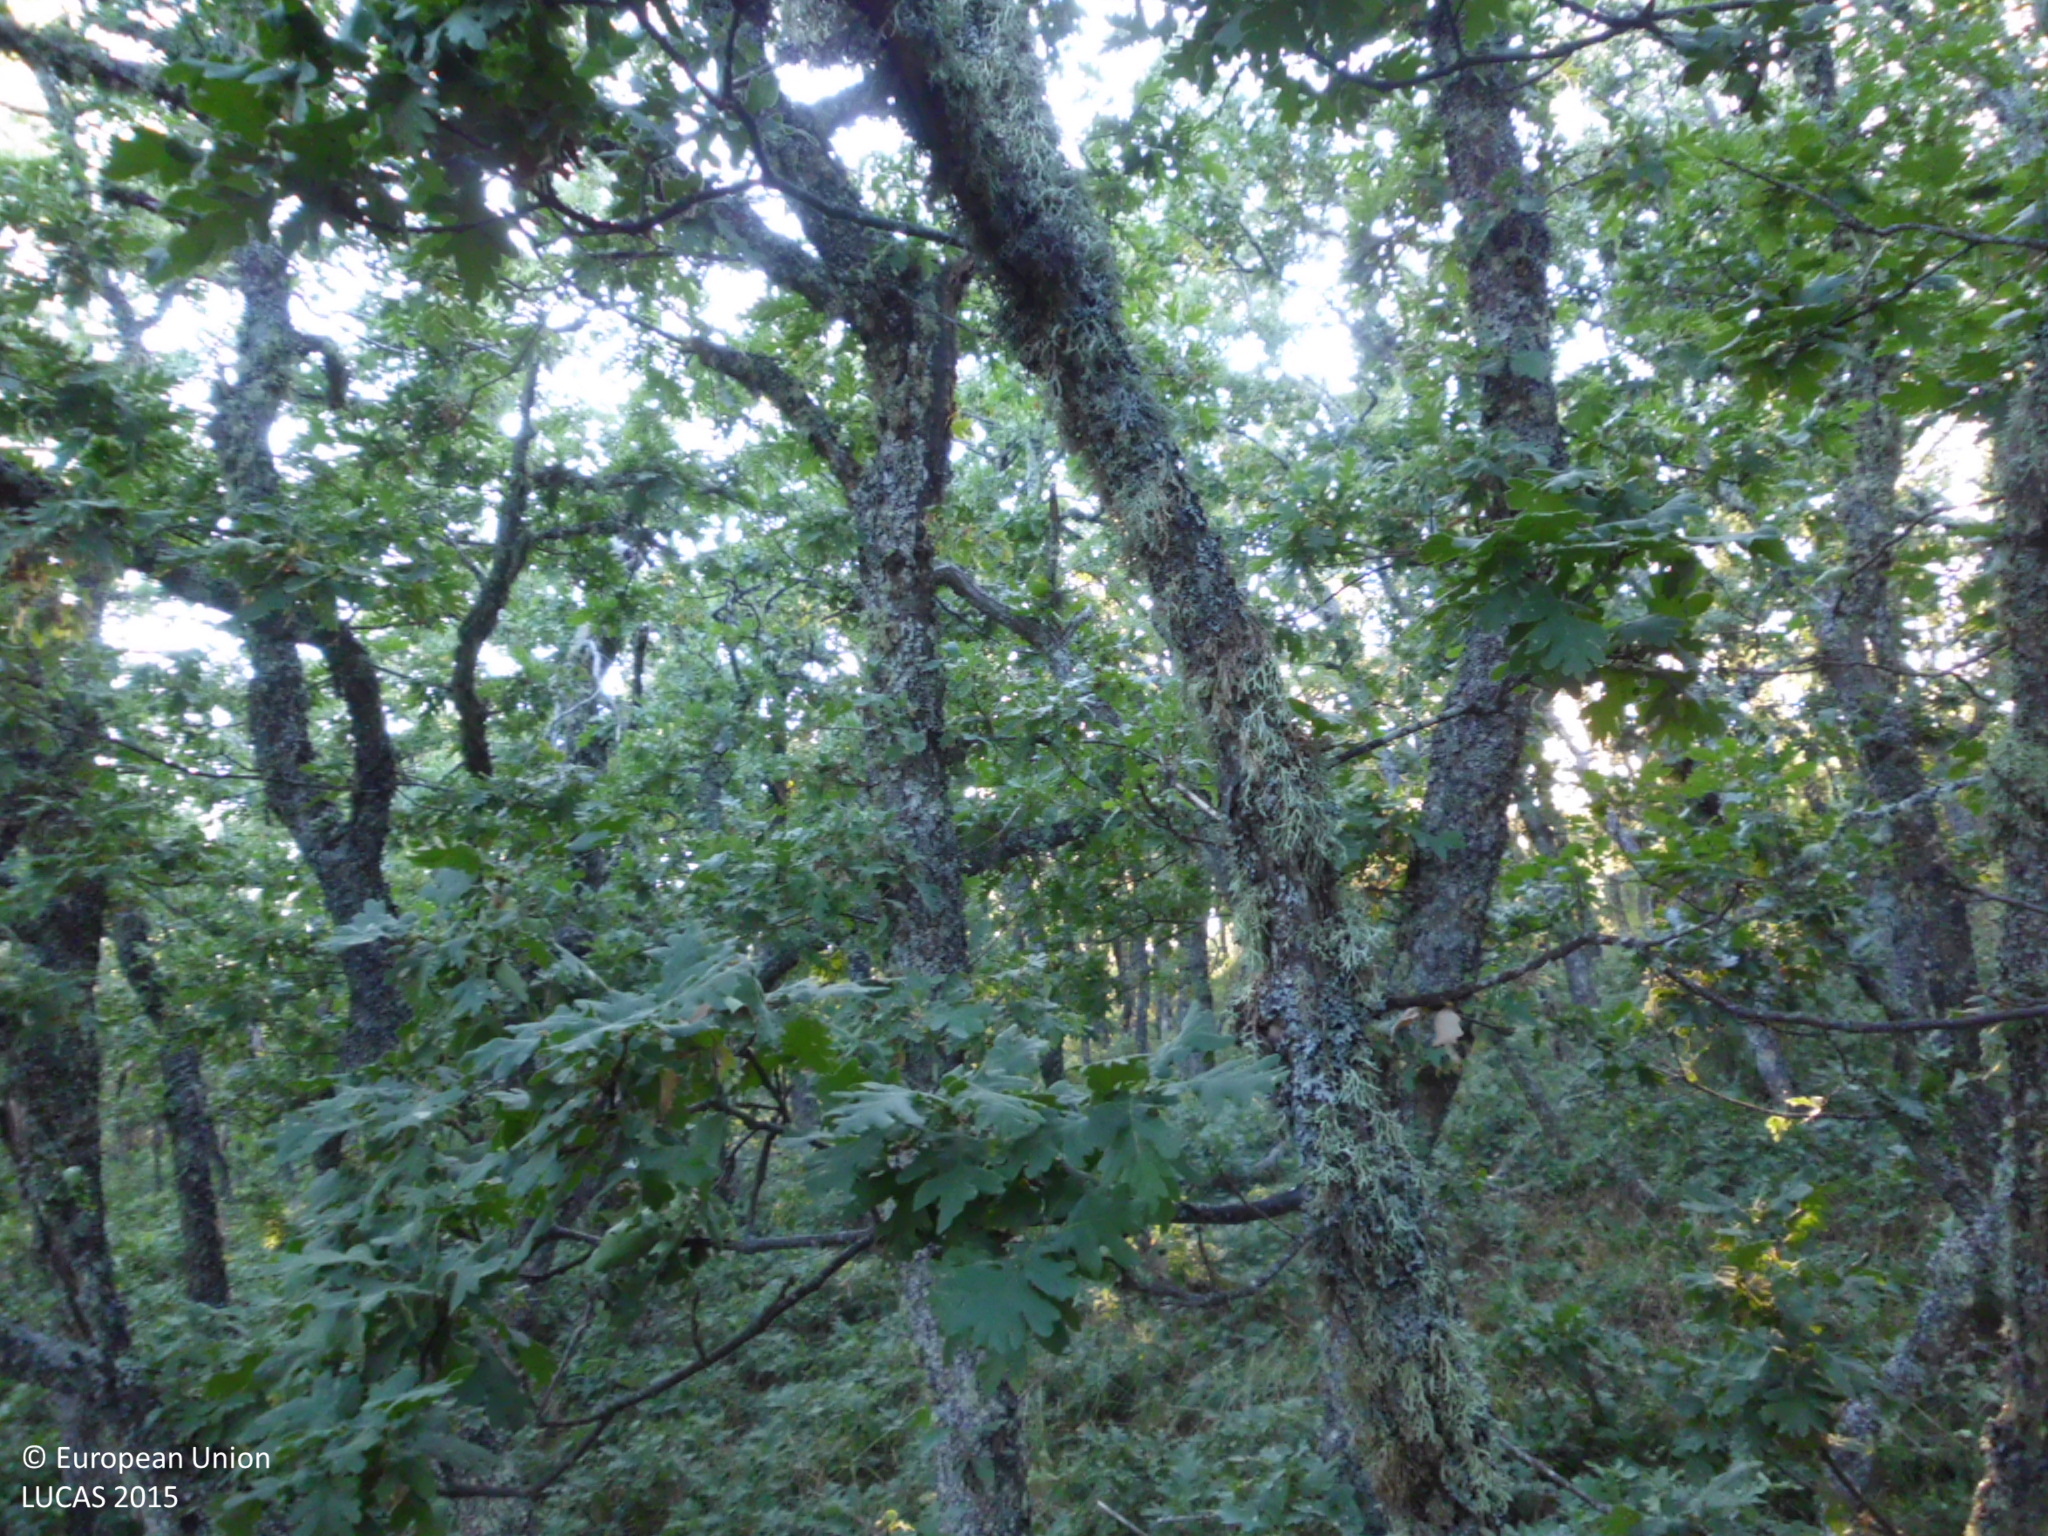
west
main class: Woodland
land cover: Broadleaved woodland
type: acidophilous oak and oak-birch forest
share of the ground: > 75 %
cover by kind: broadleaved forest trees 90 %, shrubs 10 %
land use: Semi-natural and natural areas not in use
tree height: < 5 m
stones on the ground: > 50 %
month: July
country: ES
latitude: 42.9088
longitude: -4.4716
